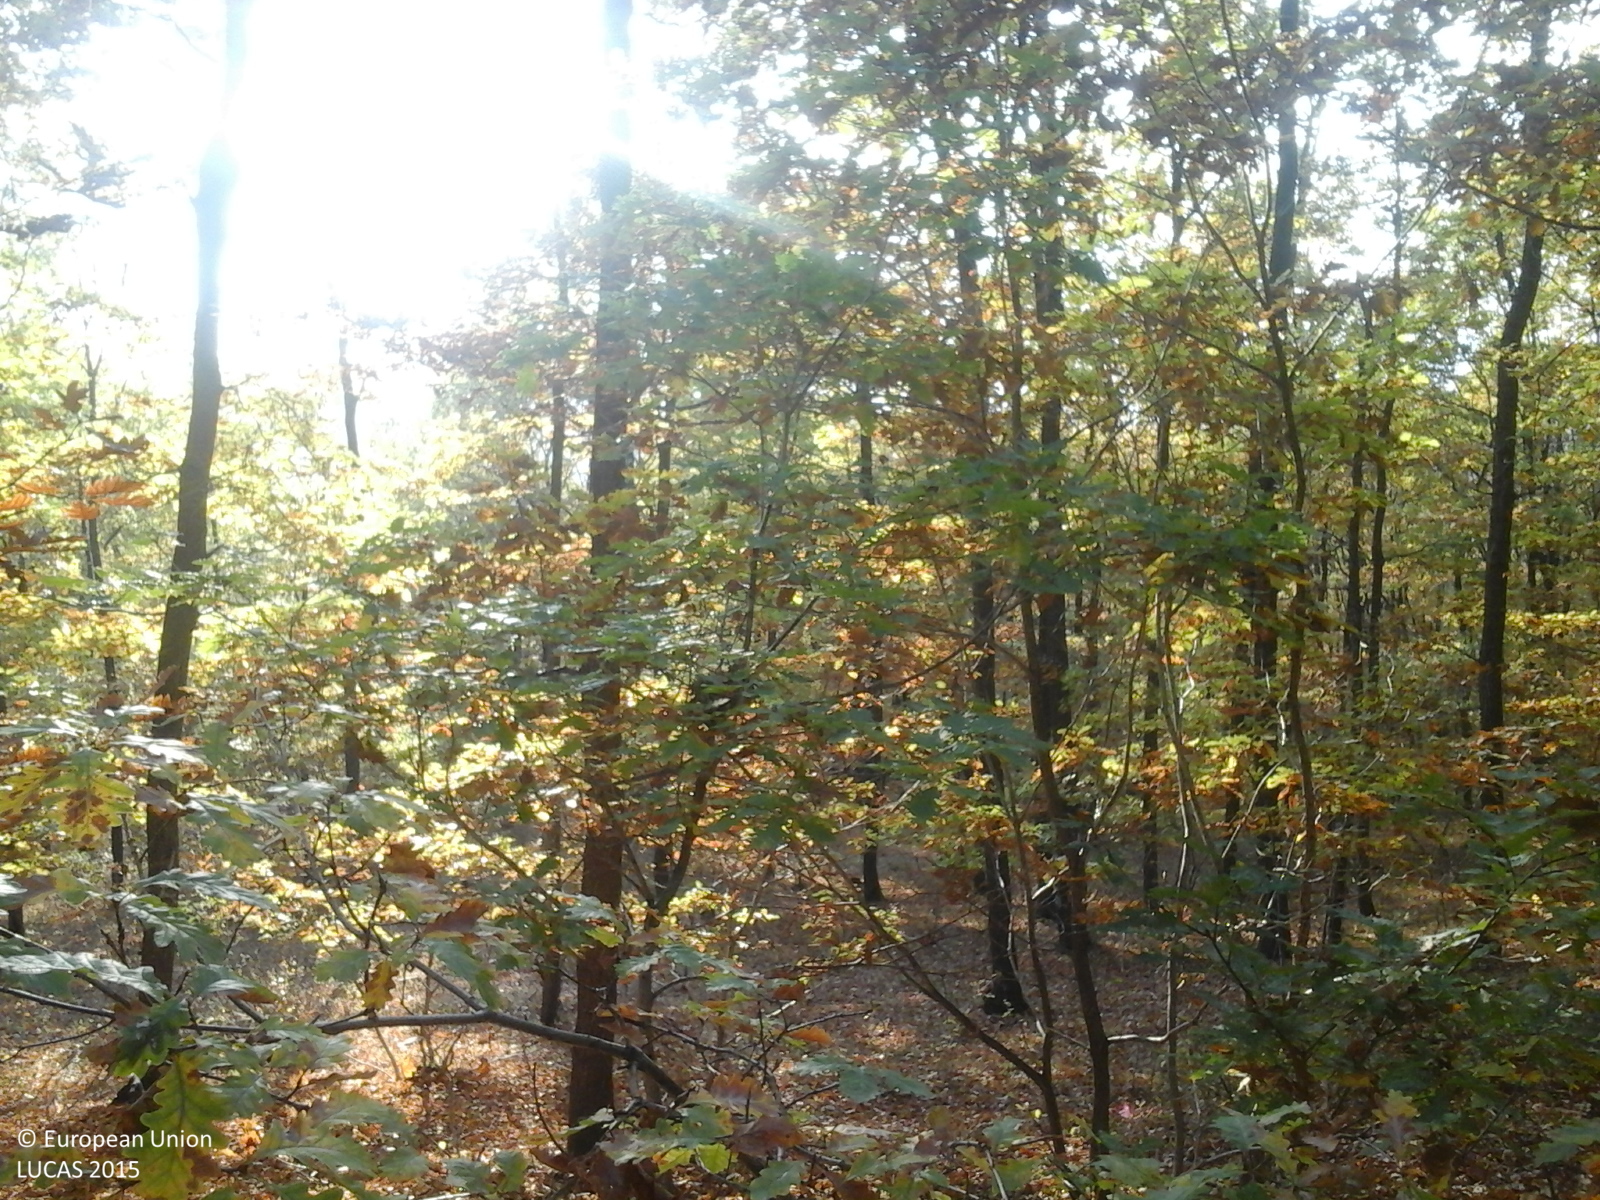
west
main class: Woodland
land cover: Broadleaved woodland
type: acidophilous oak and oak-birch forest
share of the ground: > 75 %
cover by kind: broadleaved forest trees 100 %
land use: Forestry
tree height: > 5 m
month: October
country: RO
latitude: 45.4939
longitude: 26.9915
